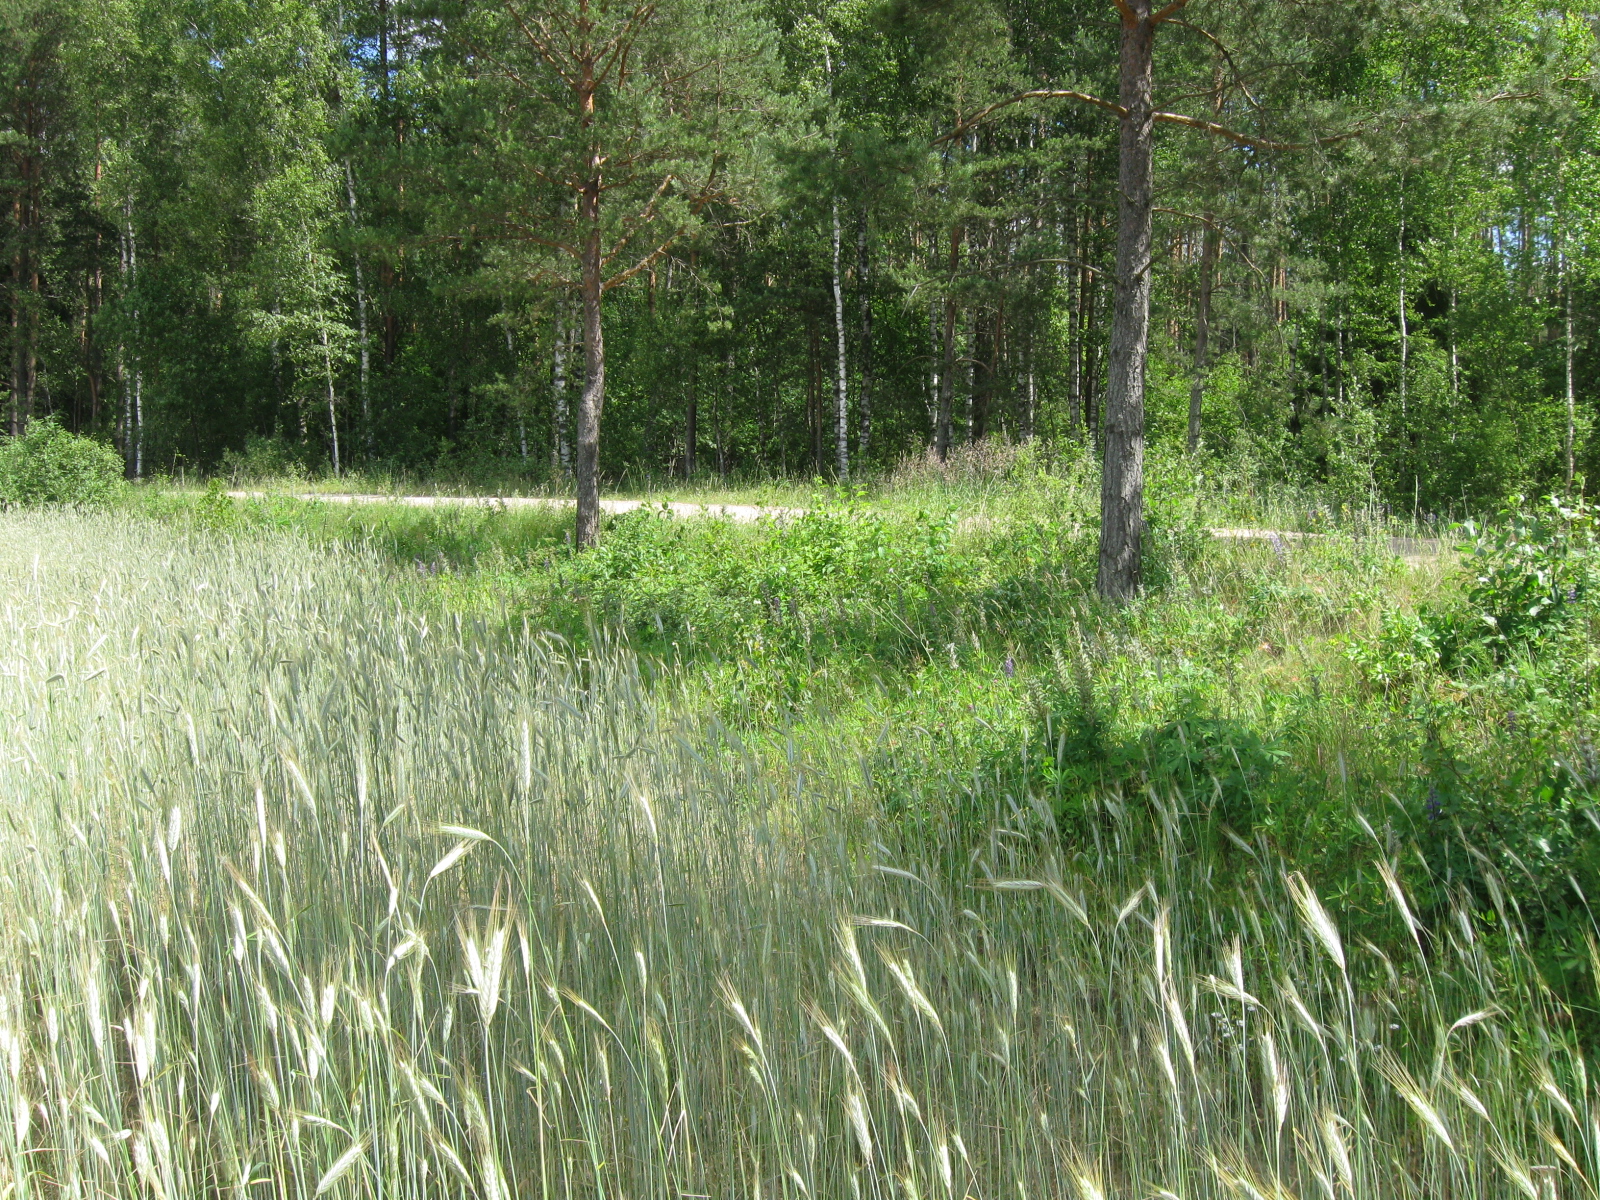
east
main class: Cropland
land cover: Rye
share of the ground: > 75 %
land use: Agriculture (excluding fallow land and kitchen gardens)
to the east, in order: Rye; Spontaneously vegetated surfaces; Lines of trees; Paved roads, cycling and walking lanes; Pine dominated mixed woodland; Other mixed woodland
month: July
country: LT
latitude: 54.3663
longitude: 24.6830
